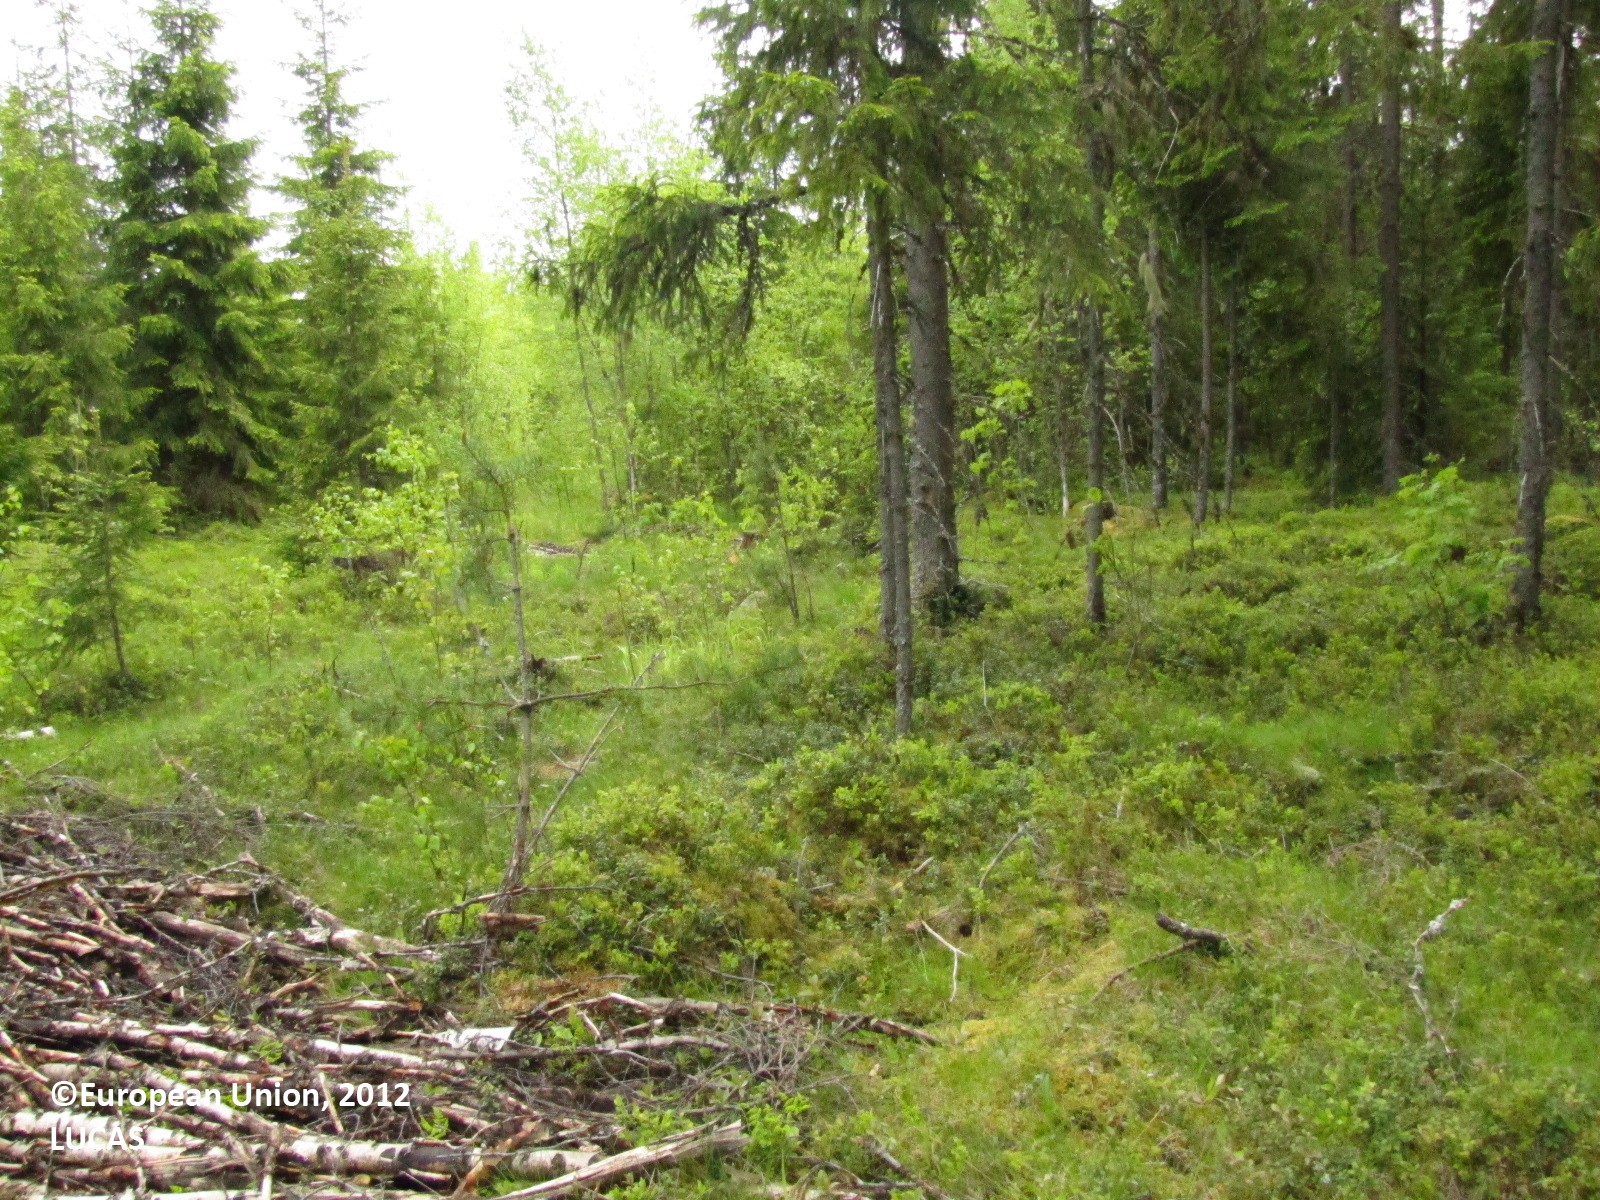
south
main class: Woodland
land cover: Spruce dominated mixed woodland
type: boreal forest
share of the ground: > 75 %
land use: Forestry
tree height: < 5 m
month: June
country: FI
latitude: 61.6398
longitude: 23.0352
